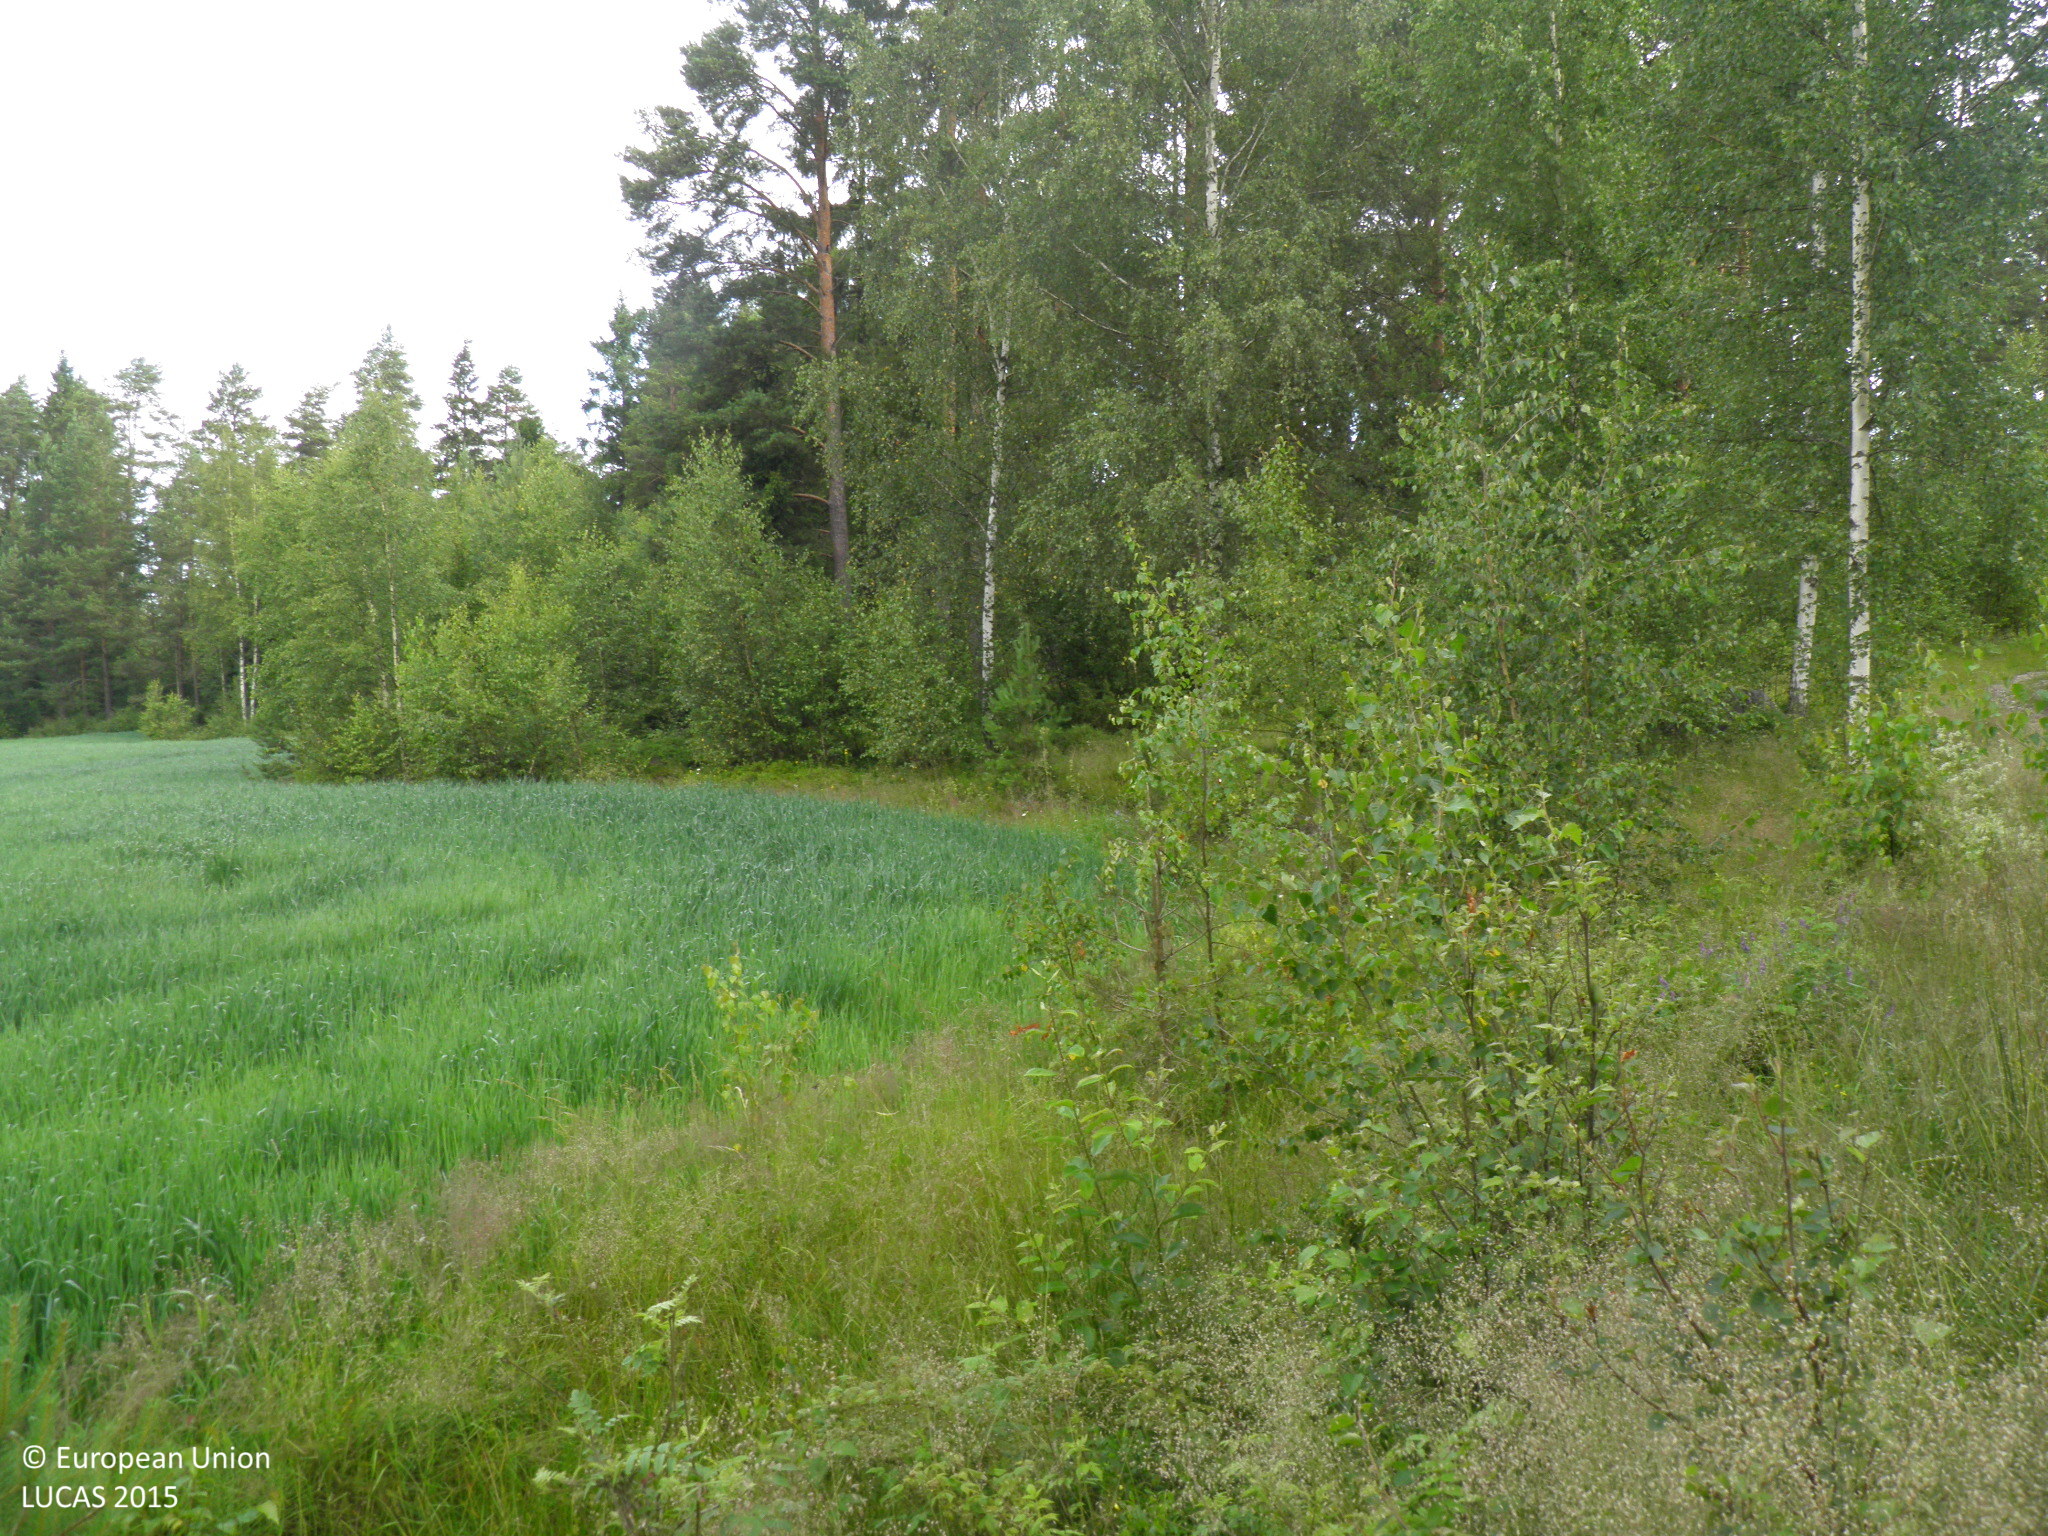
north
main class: Woodland
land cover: Pine dominated coniferous woodland
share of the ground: 50 - 75 %
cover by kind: coniferous forest trees 40 %, shrubs 30 %, broadleaved forest trees 10 %, herbaceous plants 10 %, lichens and mosses 10 %
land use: Forestry
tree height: > 5 m
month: July
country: FI
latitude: 60.6835
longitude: 21.3876
